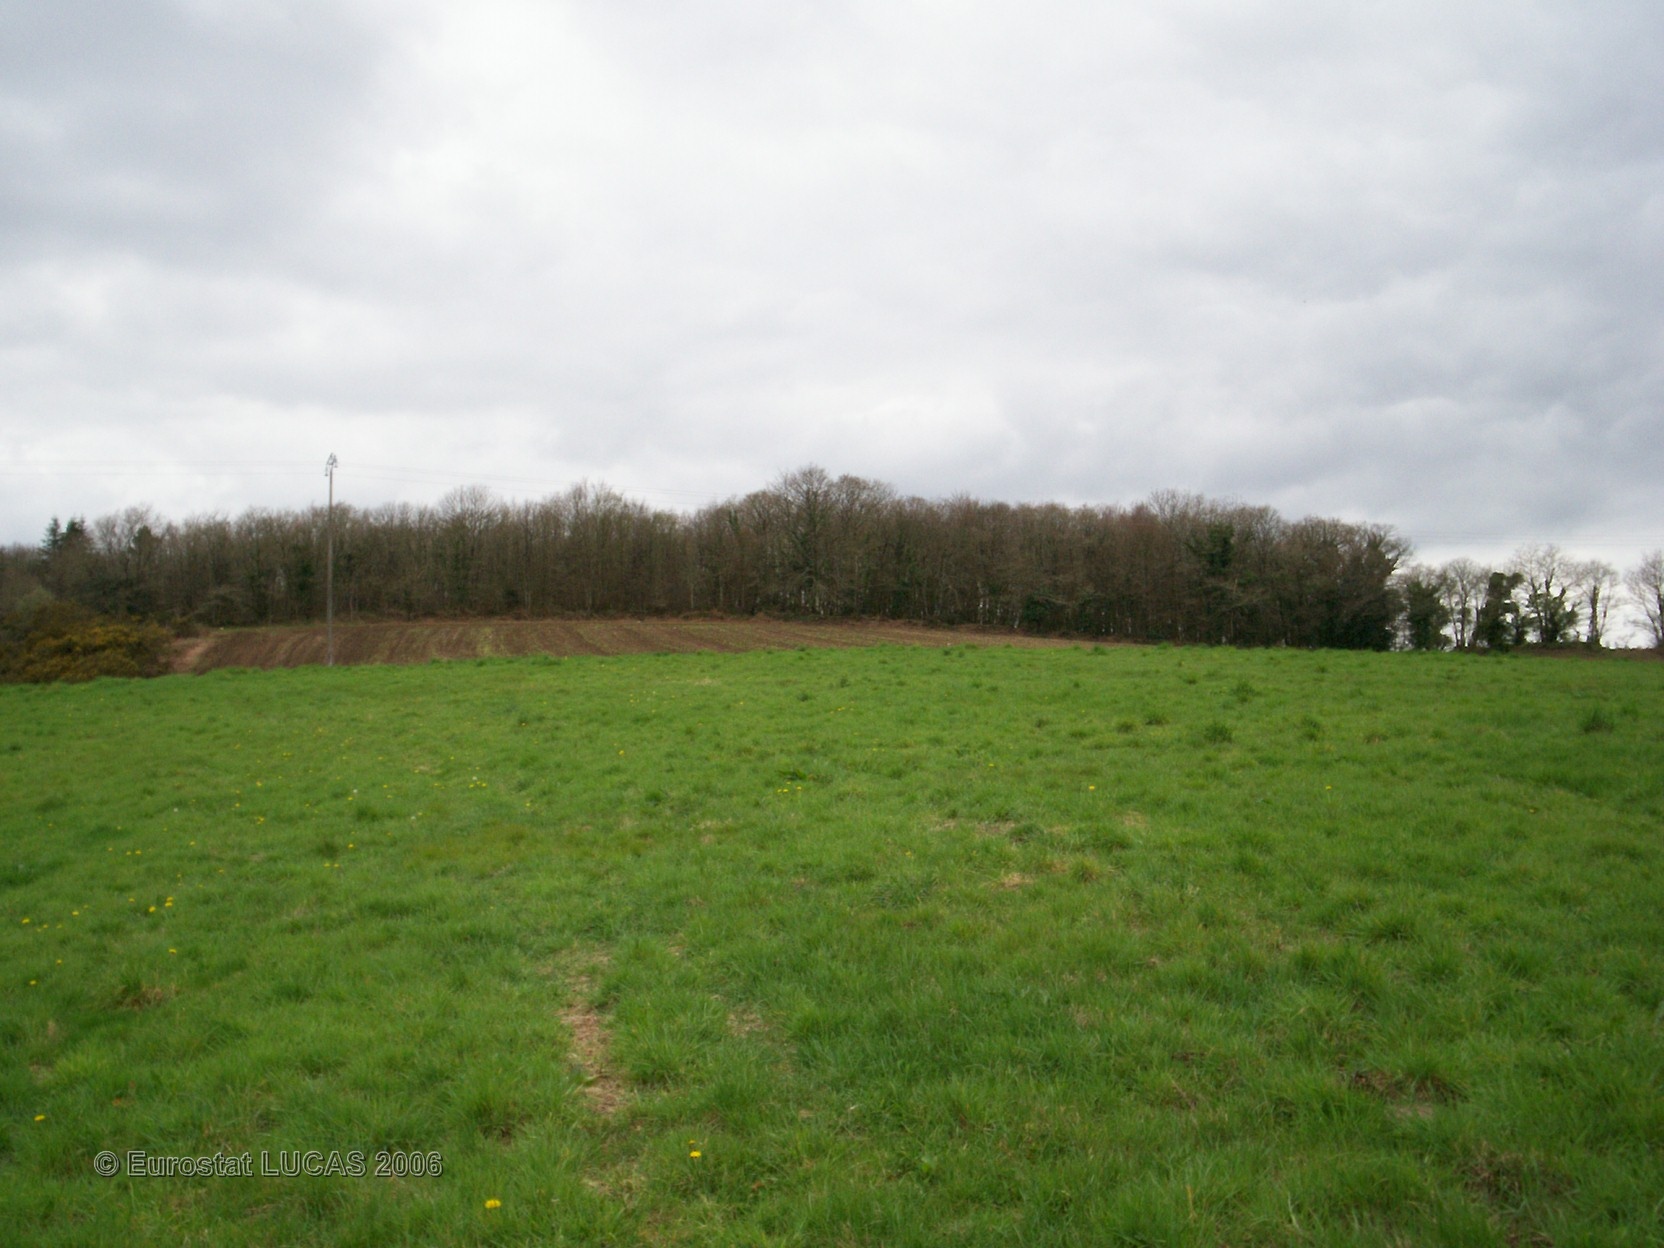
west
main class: Grassland
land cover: Grassland without tree/shrub cover
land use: Agriculture (excluding fallow land and kitchen gardens)
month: April
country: FR
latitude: 47.9883
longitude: -3.5166
